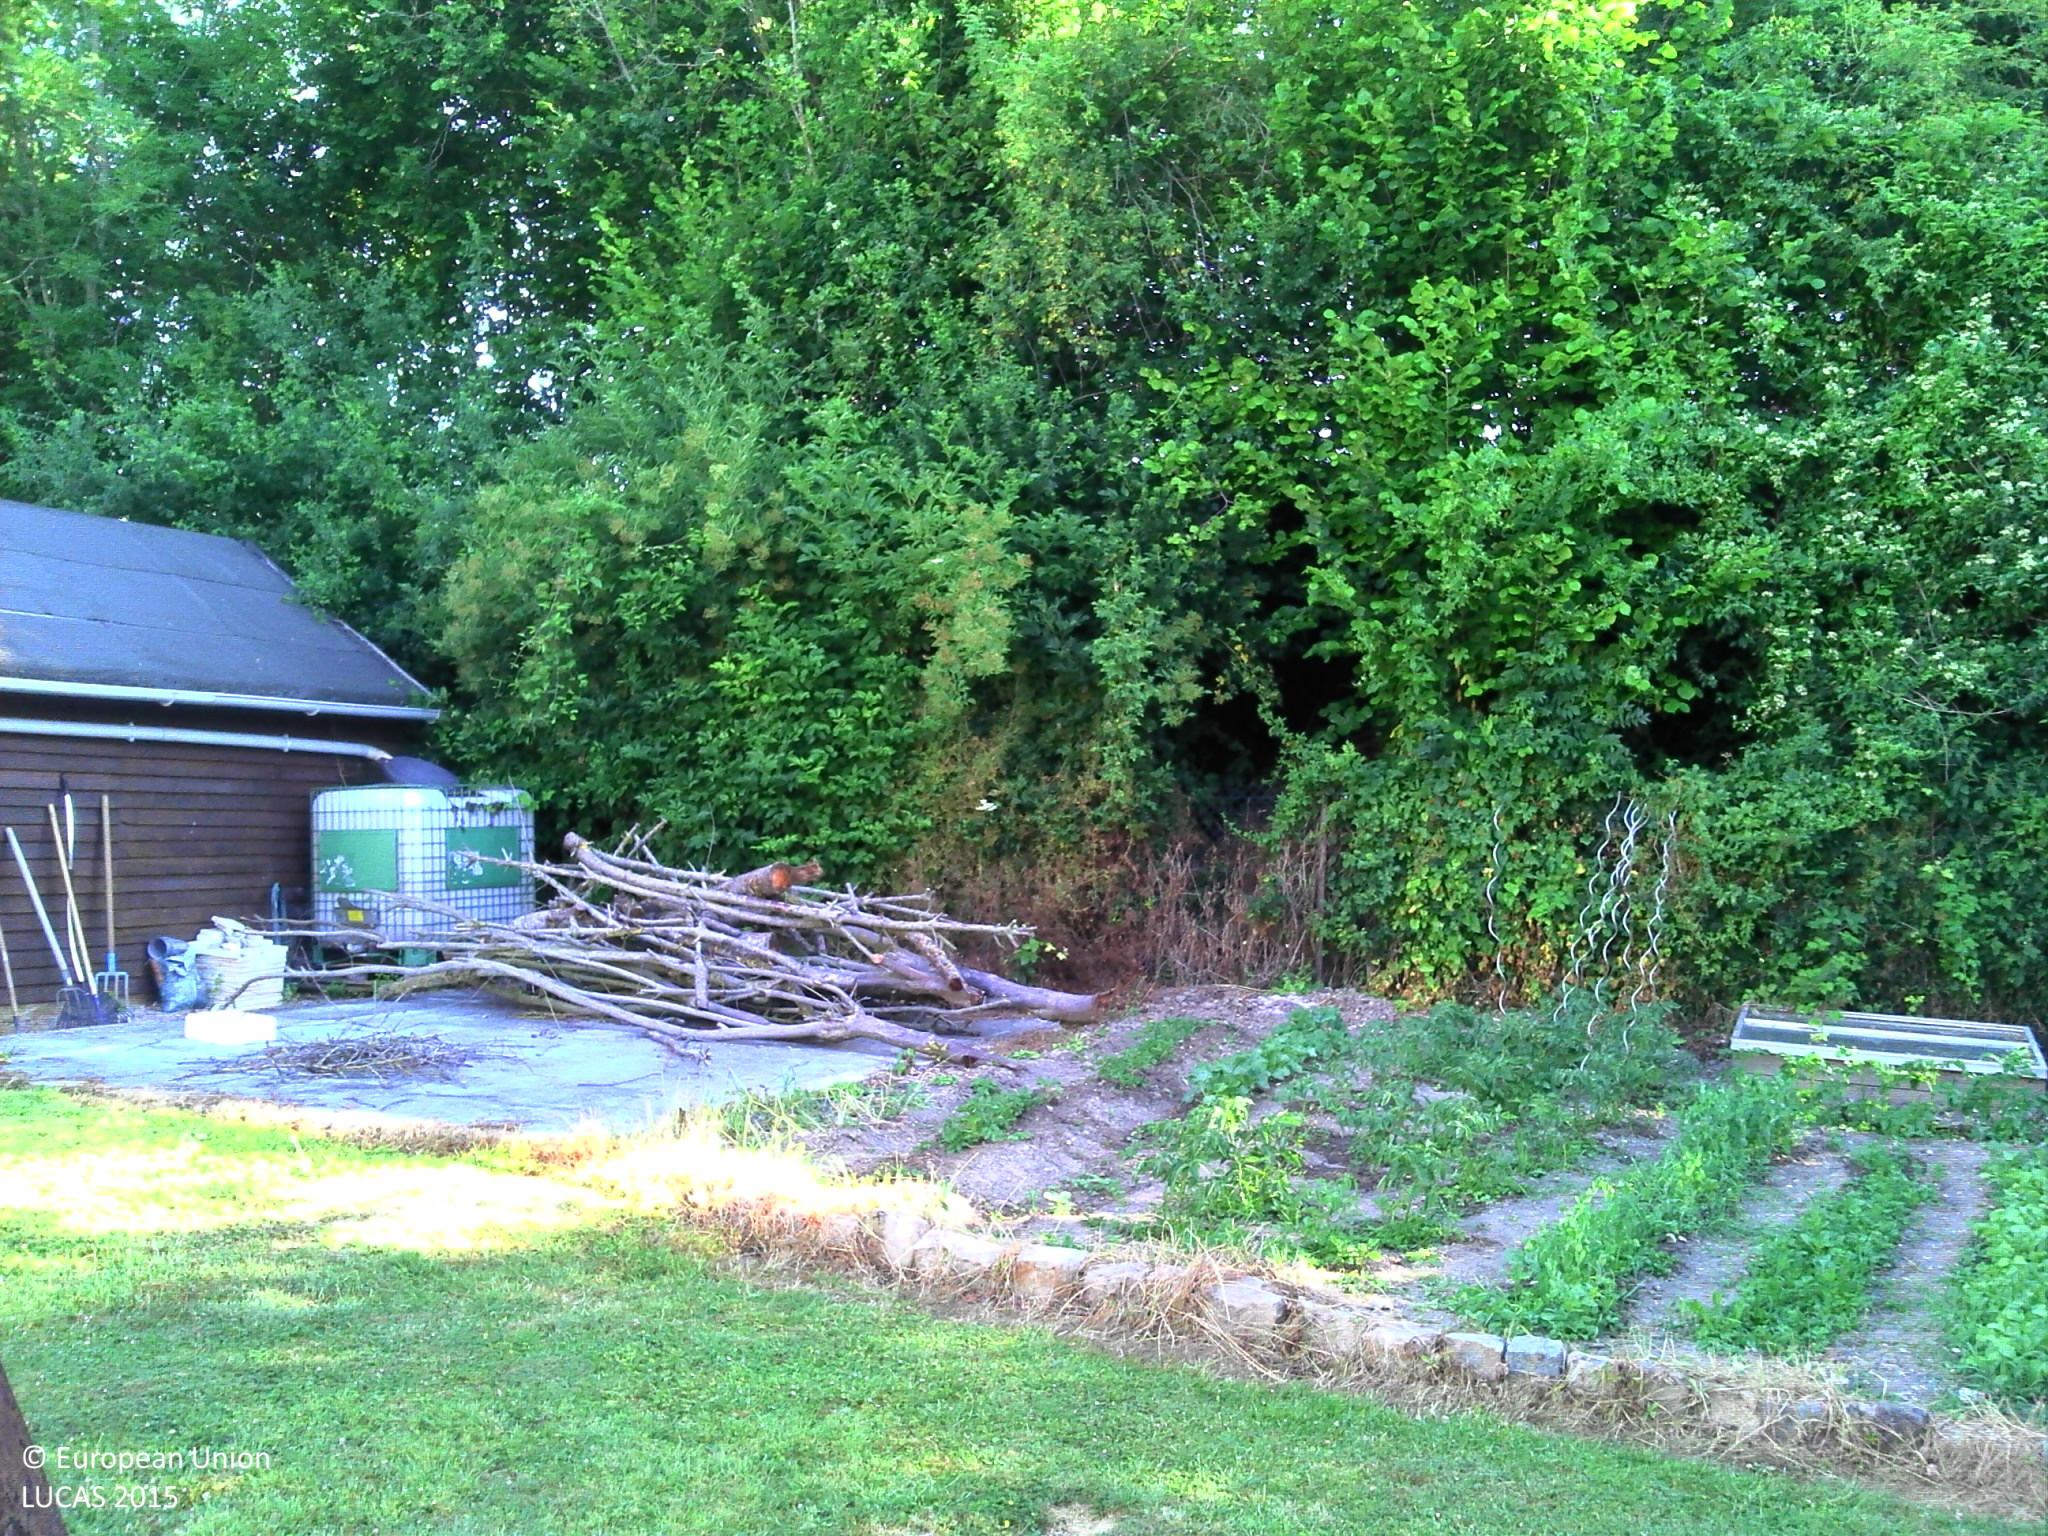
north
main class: Grassland
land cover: Grassland with sparse tree/shrub cover
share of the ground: > 75 %
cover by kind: herbaceous plants 95 %, coniferous forest trees 5 %
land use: Residential
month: June
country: FR
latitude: 49.4560
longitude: 2.3305
